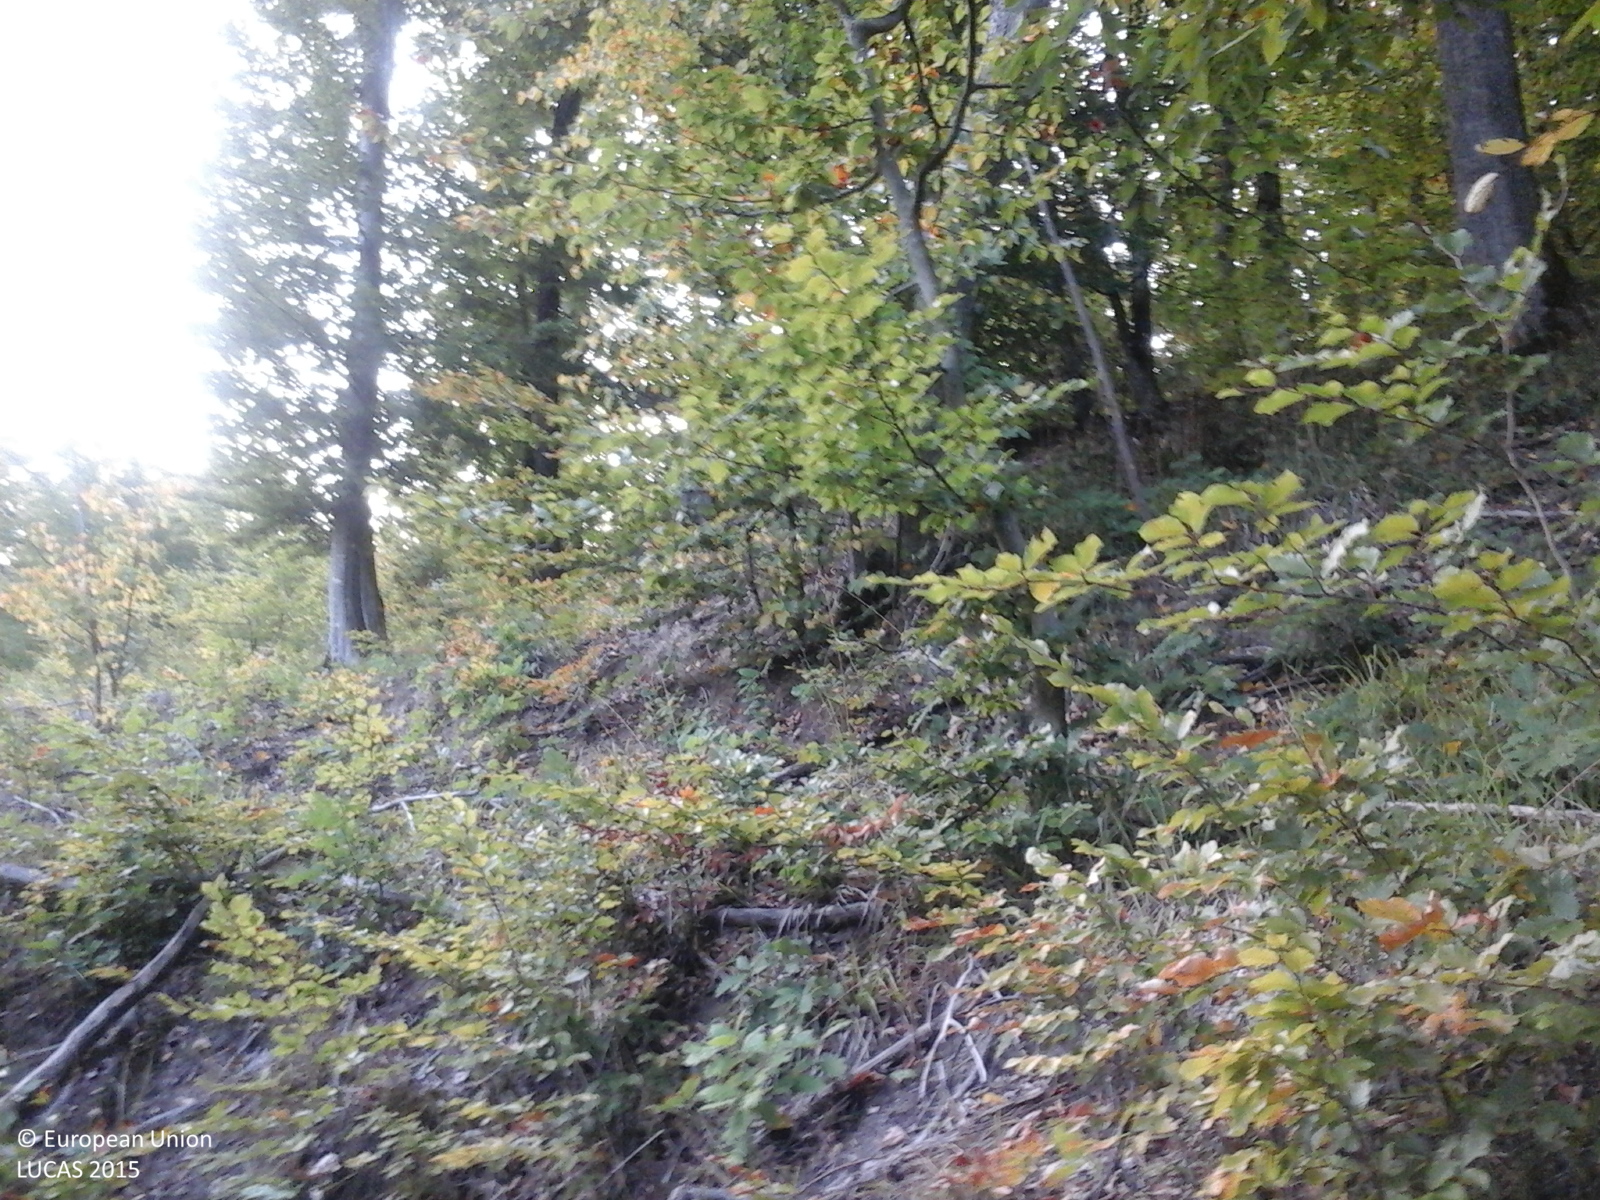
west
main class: Woodland
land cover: Broadleaved woodland
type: acidophilous oak and oak-birch forest
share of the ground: > 75 %
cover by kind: broadleaved forest trees 100 %
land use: Forestry
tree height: > 5 m
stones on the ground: < 10 %
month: September
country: RO
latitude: 45.7185
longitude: 22.0789
